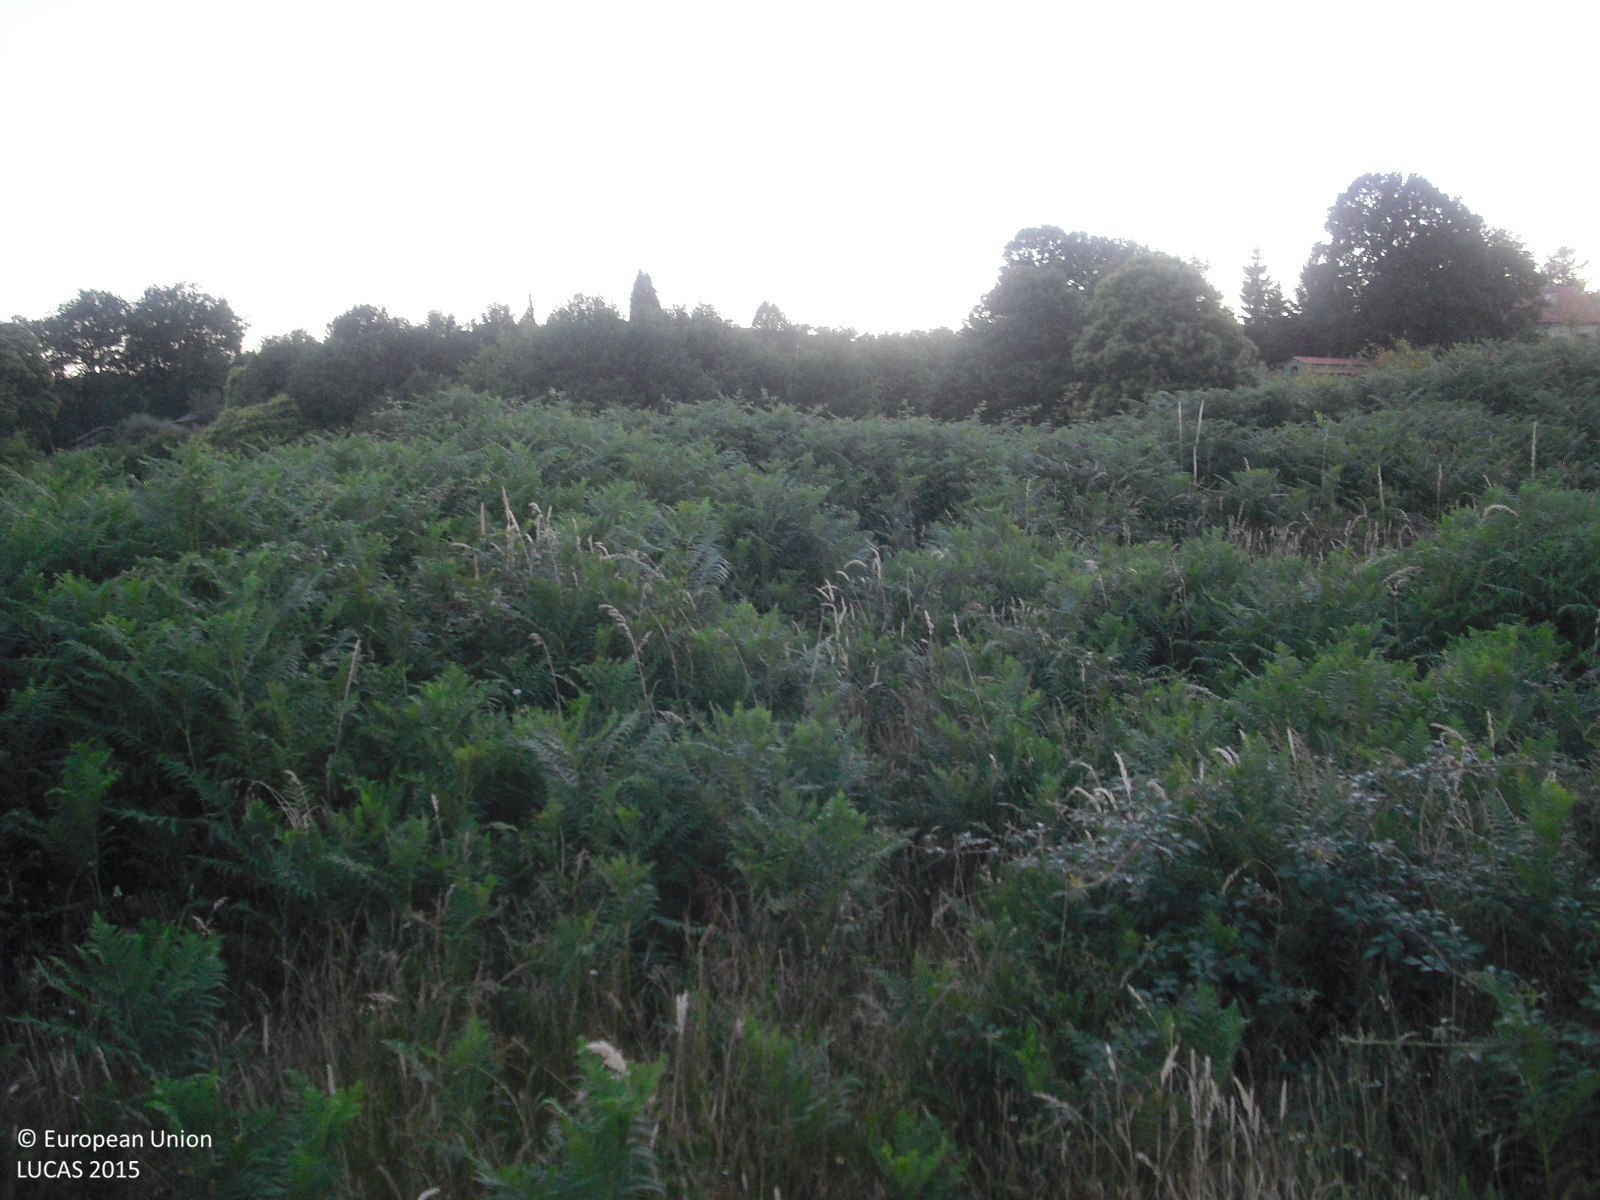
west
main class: Shrubland
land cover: Shrubland without tree cover
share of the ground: 50 - 75 %
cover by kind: shrubs 70 %, herbaceous plants 30 %
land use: Abandoned areas
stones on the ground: 25 - 50 %
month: June
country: ES
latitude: 42.4697
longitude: -7.8731
